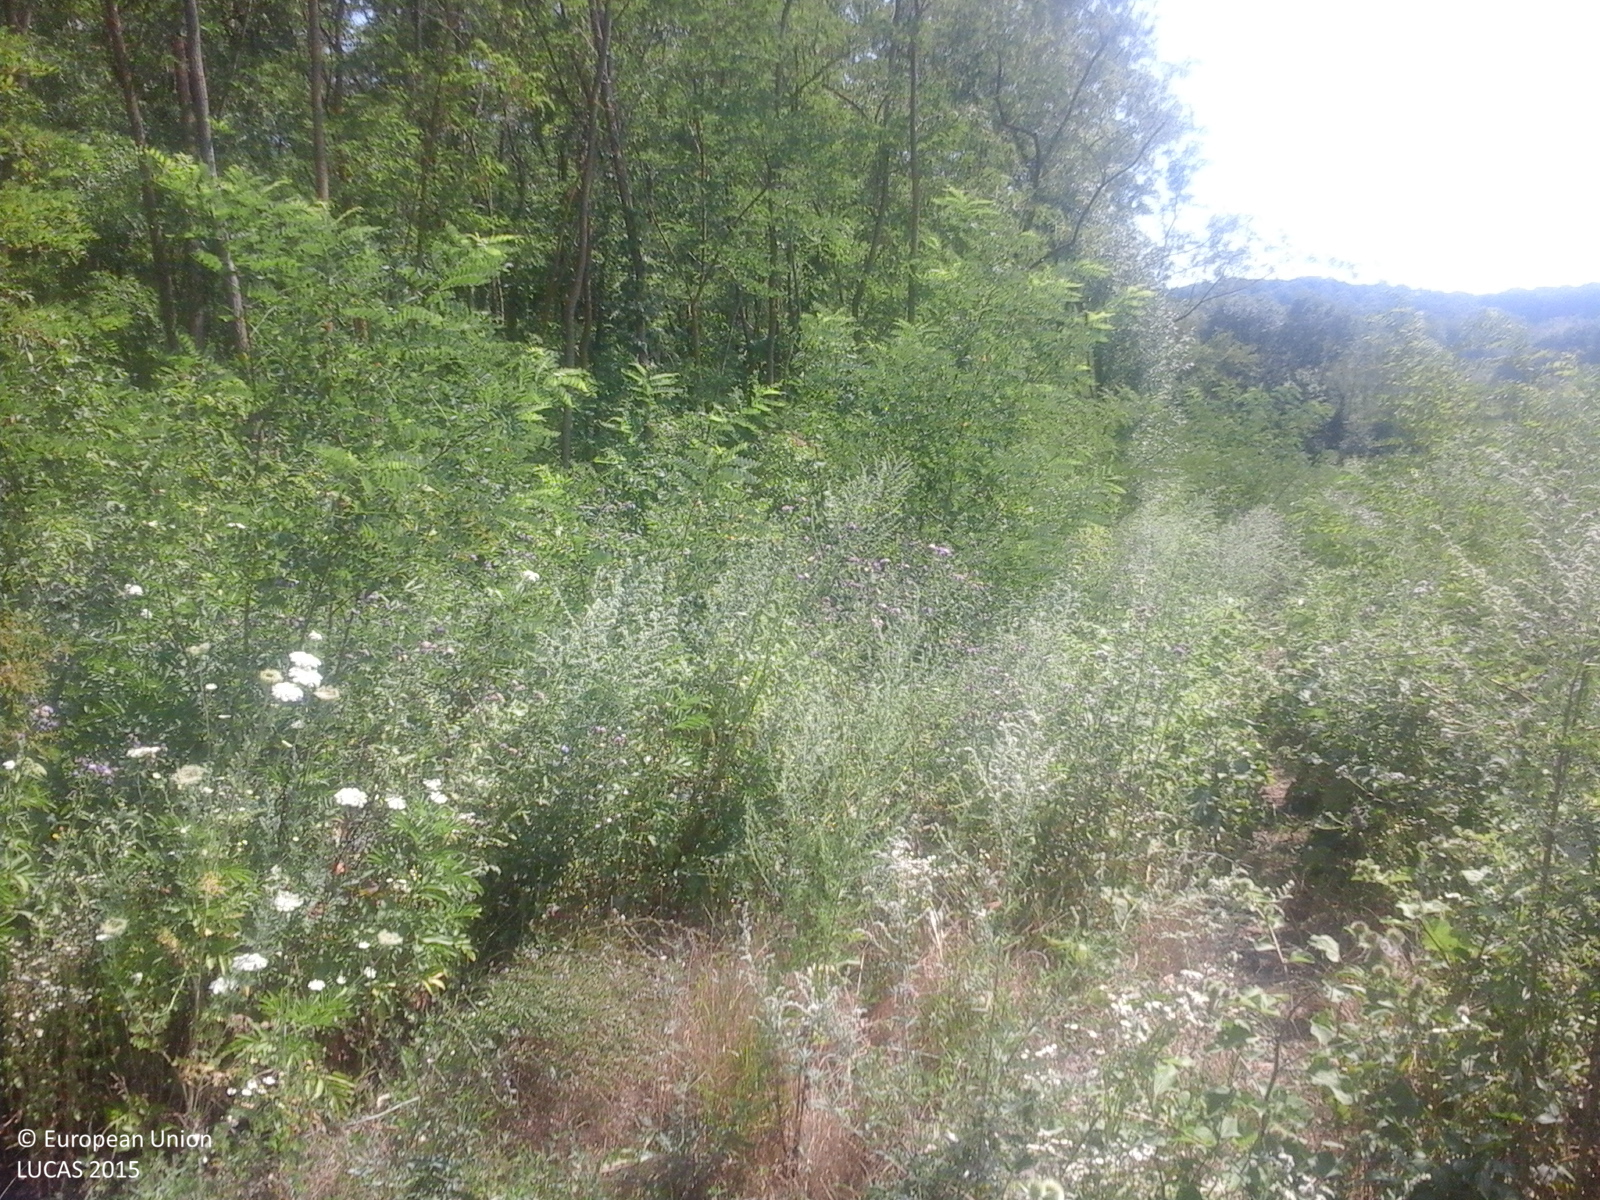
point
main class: Woodland
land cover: Broadleaved woodland
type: broadleaved evergreen forest
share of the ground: > 75 %
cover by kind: broadleaved forest trees 100 %
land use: Forestry
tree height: > 5 m
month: July
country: RO
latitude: 46.6532
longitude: 27.9899
